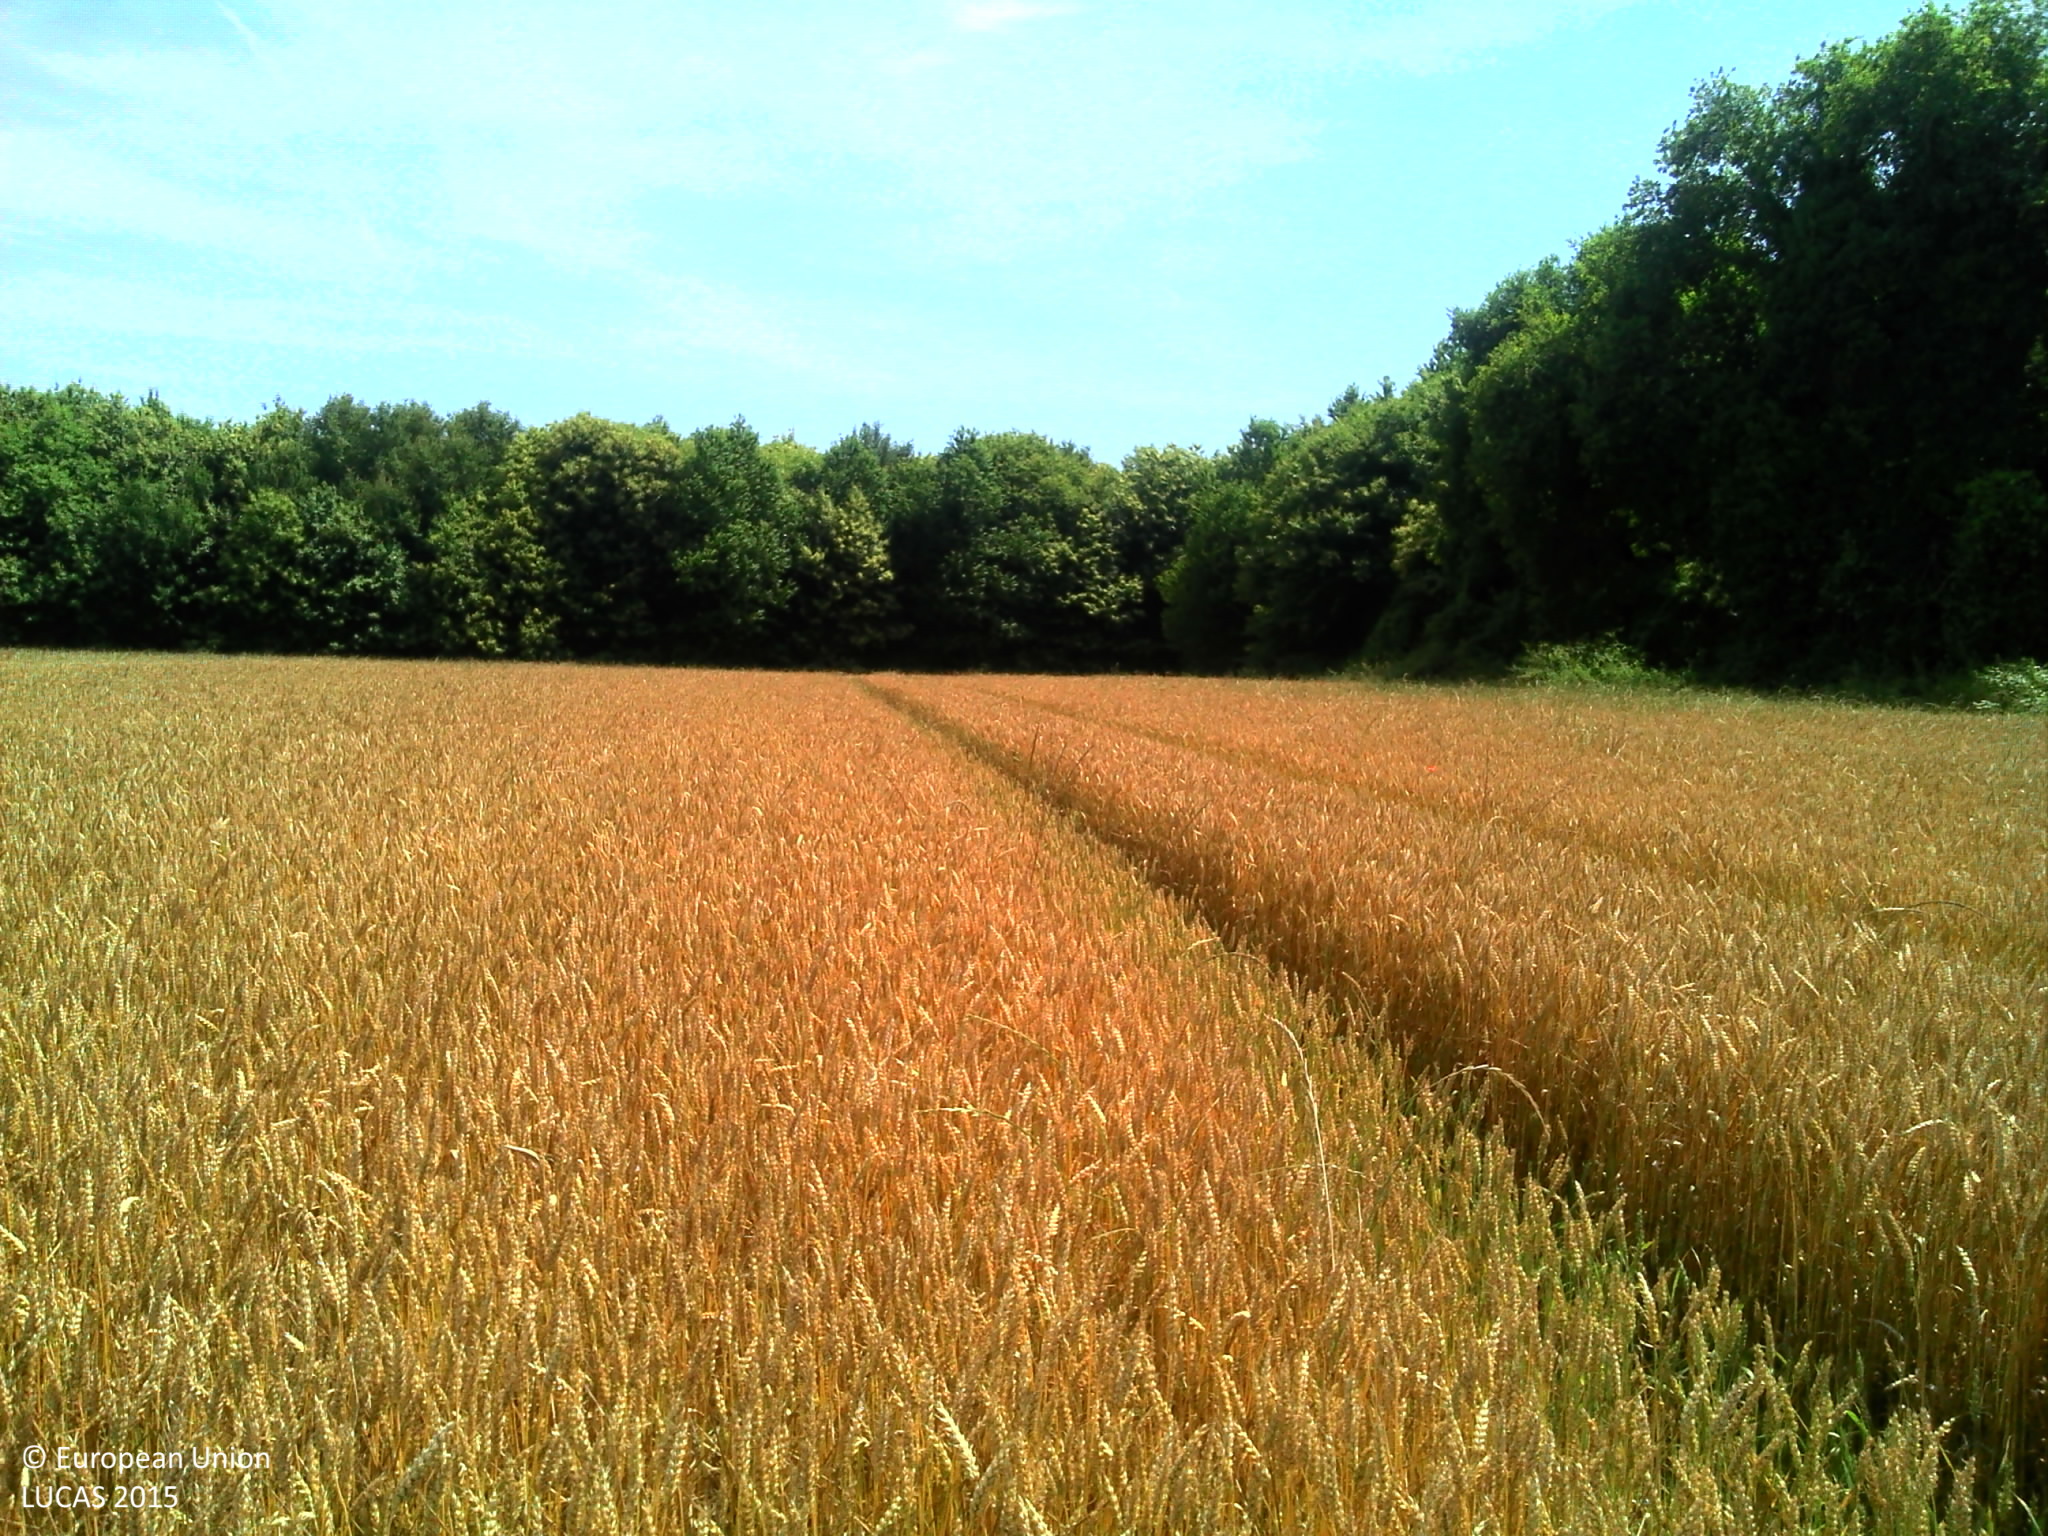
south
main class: Cropland
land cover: Common wheat
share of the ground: > 75 %
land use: Agriculture (excluding fallow land and kitchen gardens)
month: June
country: FR
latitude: 45.7979
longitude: -0.8467
